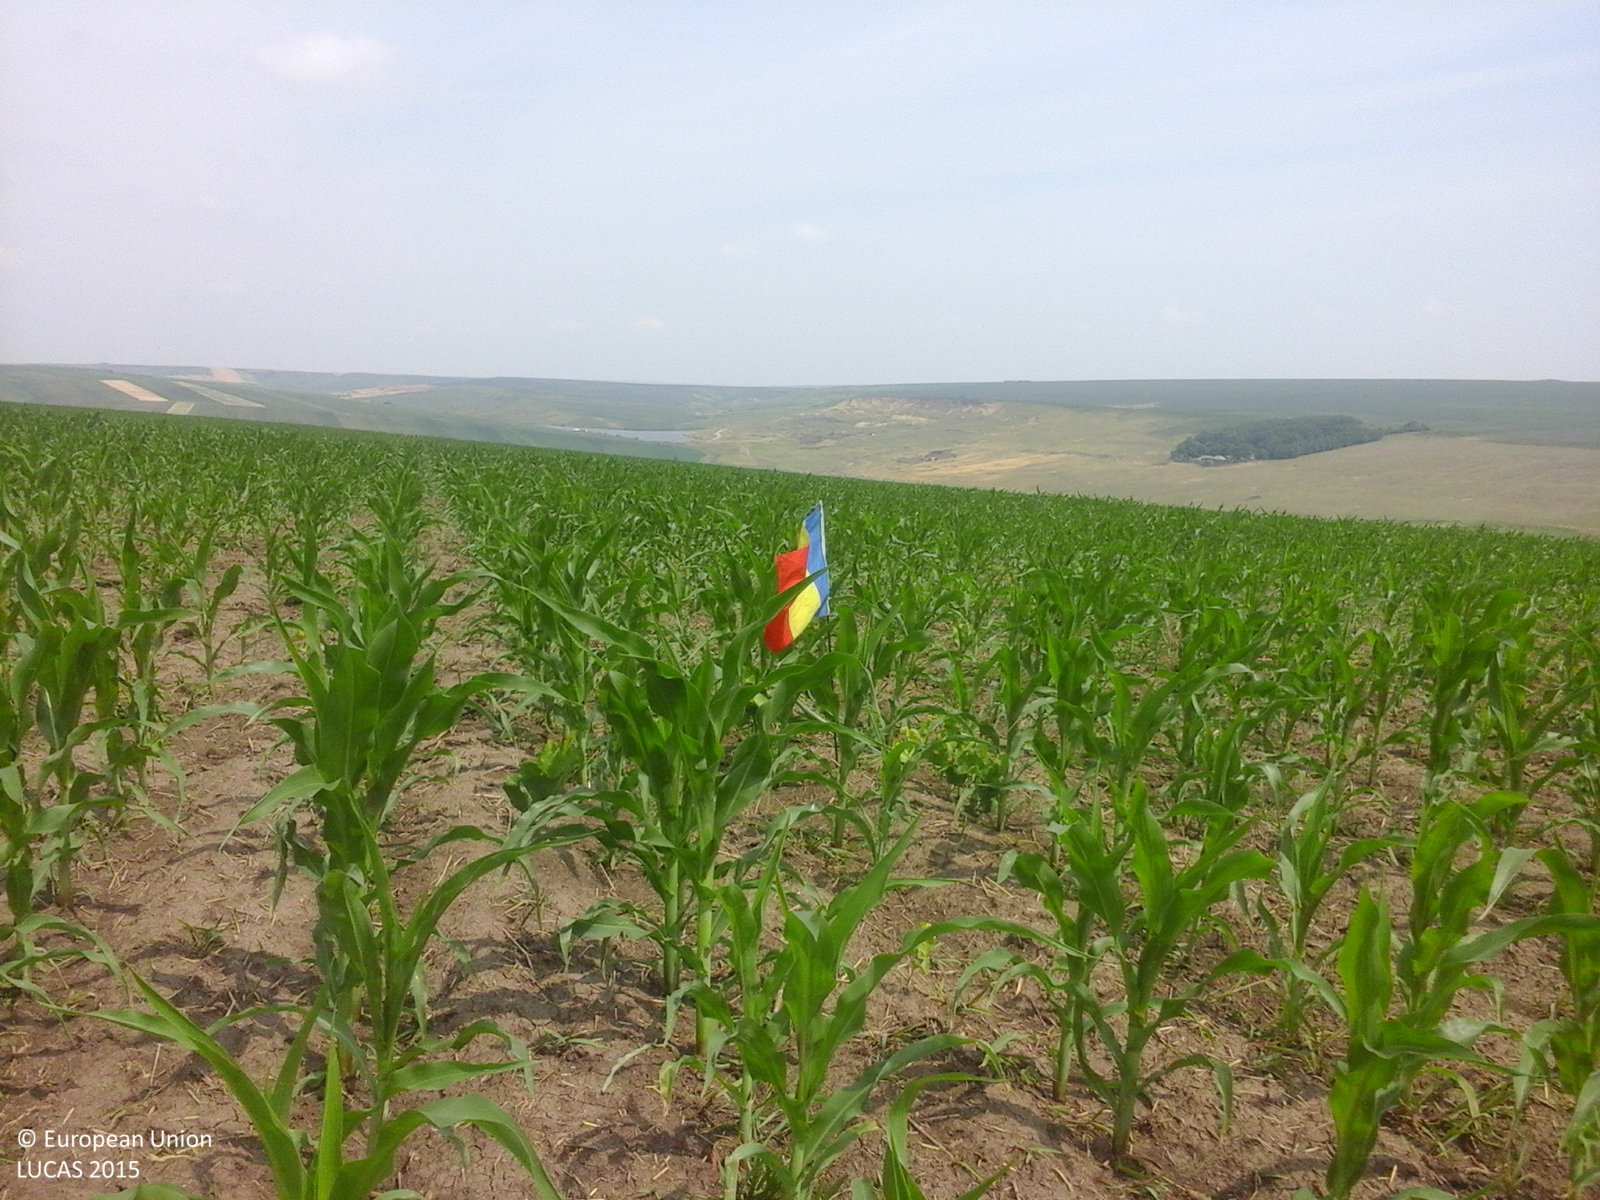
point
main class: Cropland
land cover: Maize
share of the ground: 50 - 75 %
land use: Agriculture (excluding fallow land and kitchen gardens)
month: June
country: RO
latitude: 47.4011
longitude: 27.0239
